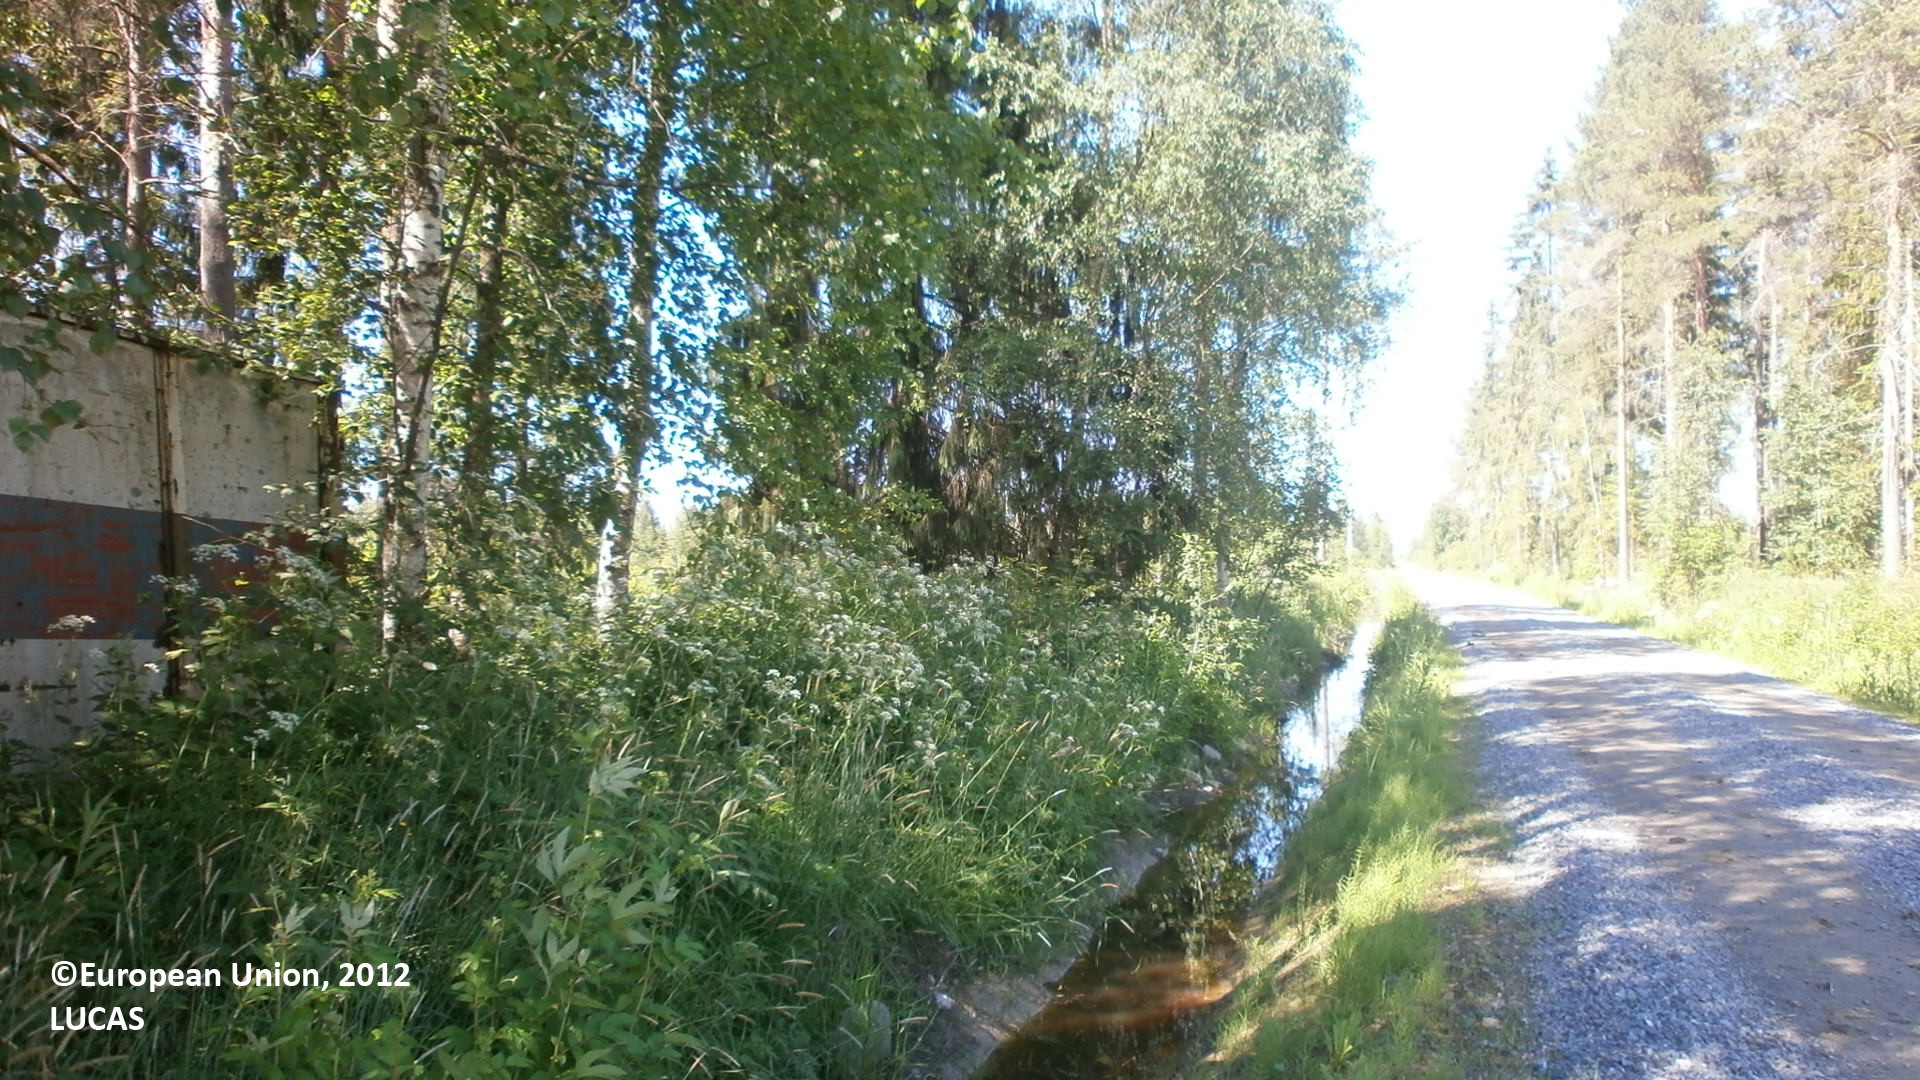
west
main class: Woodland
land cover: Spruce dominated mixed woodland
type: boreal forest
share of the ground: 50 - 75 %
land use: Forestry
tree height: > 5 m
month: July
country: FI
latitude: 63.9670
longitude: 24.8886
